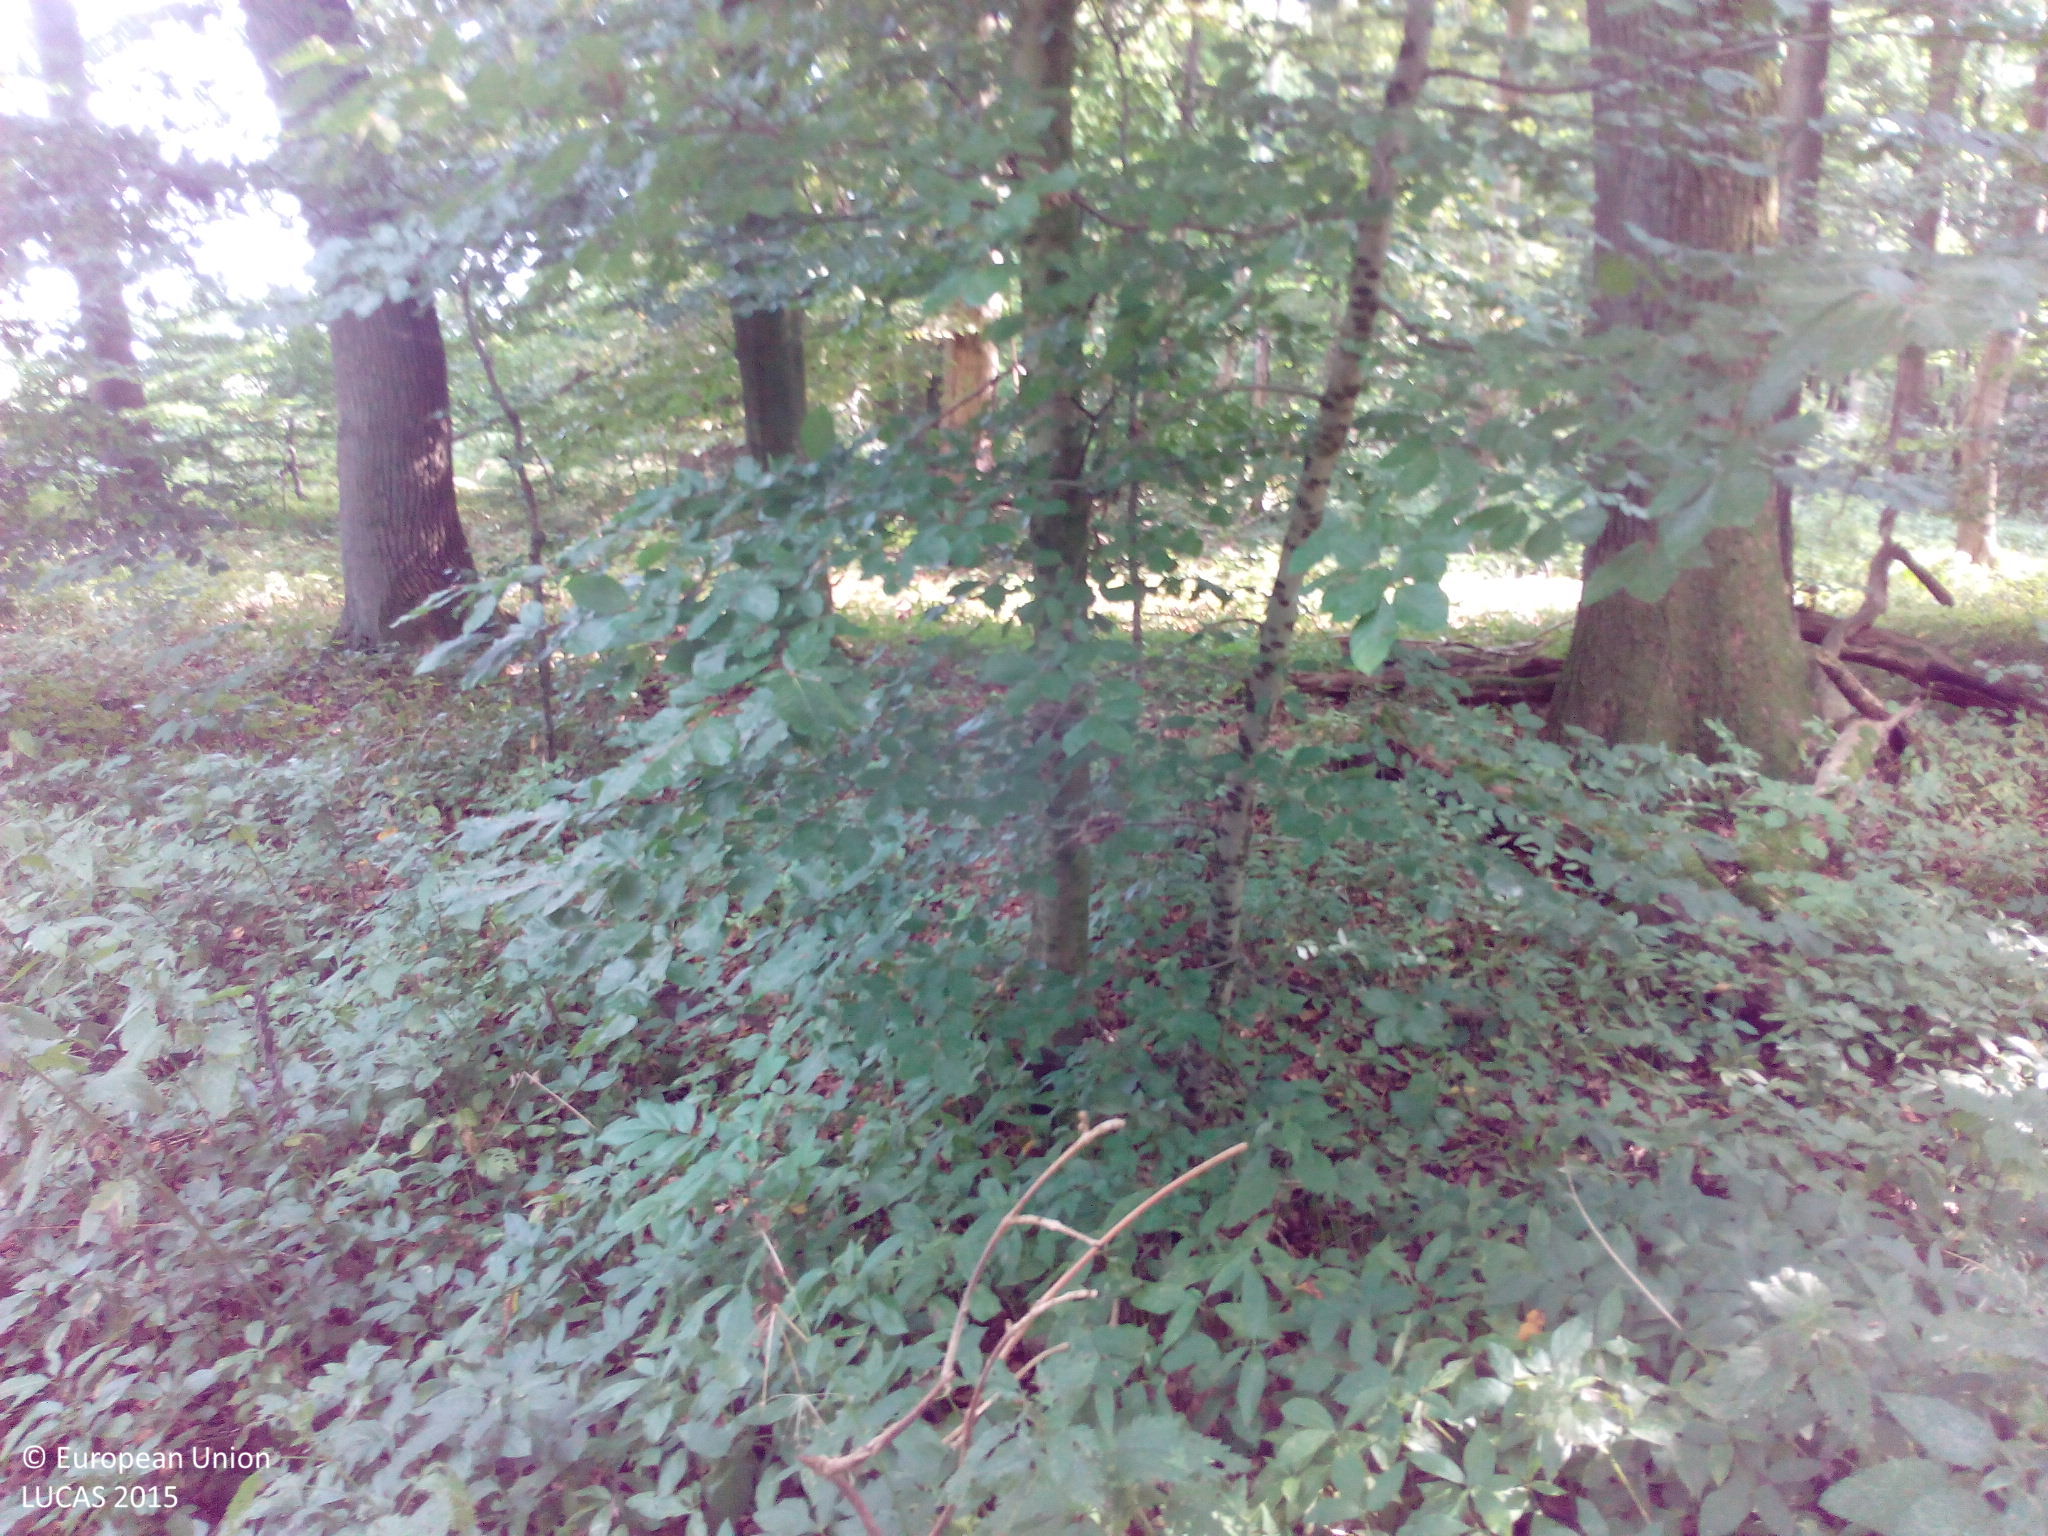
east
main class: Woodland
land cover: Broadleaved woodland
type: mesophytic deciduous forest
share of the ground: > 75 %
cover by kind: broadleaved forest trees 90 %, shrubs 5 %, herbaceous plants 5 %
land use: Forestry
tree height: > 5 m
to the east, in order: Broadleaved woodland; Inland fresh running water; Spontaneously vegetated surfaces; Grassland without tree/shrub cover
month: August
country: DE
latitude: 54.2181
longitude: 12.6521
